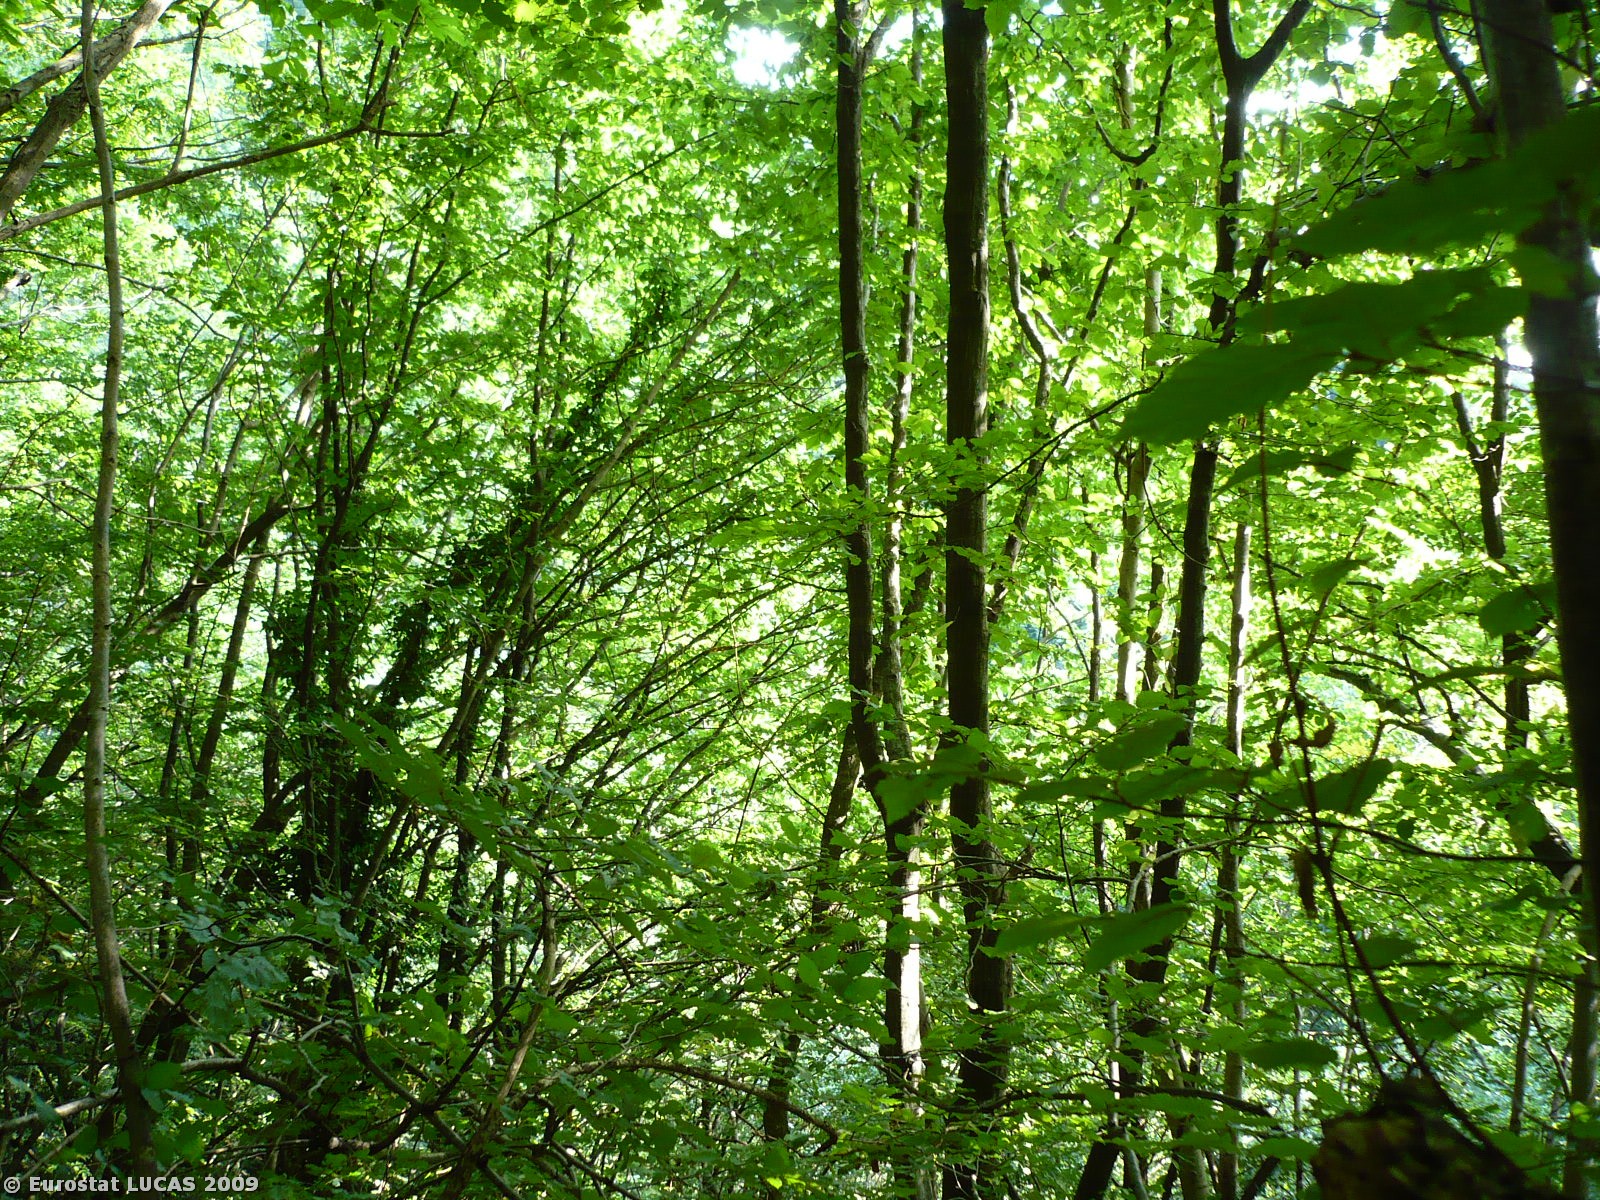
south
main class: Woodland
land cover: Broadleaved woodland
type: mesophytic deciduous forest
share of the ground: > 75 %
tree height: > 5 m
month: August
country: SI
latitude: 46.1615
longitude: 13.6873
